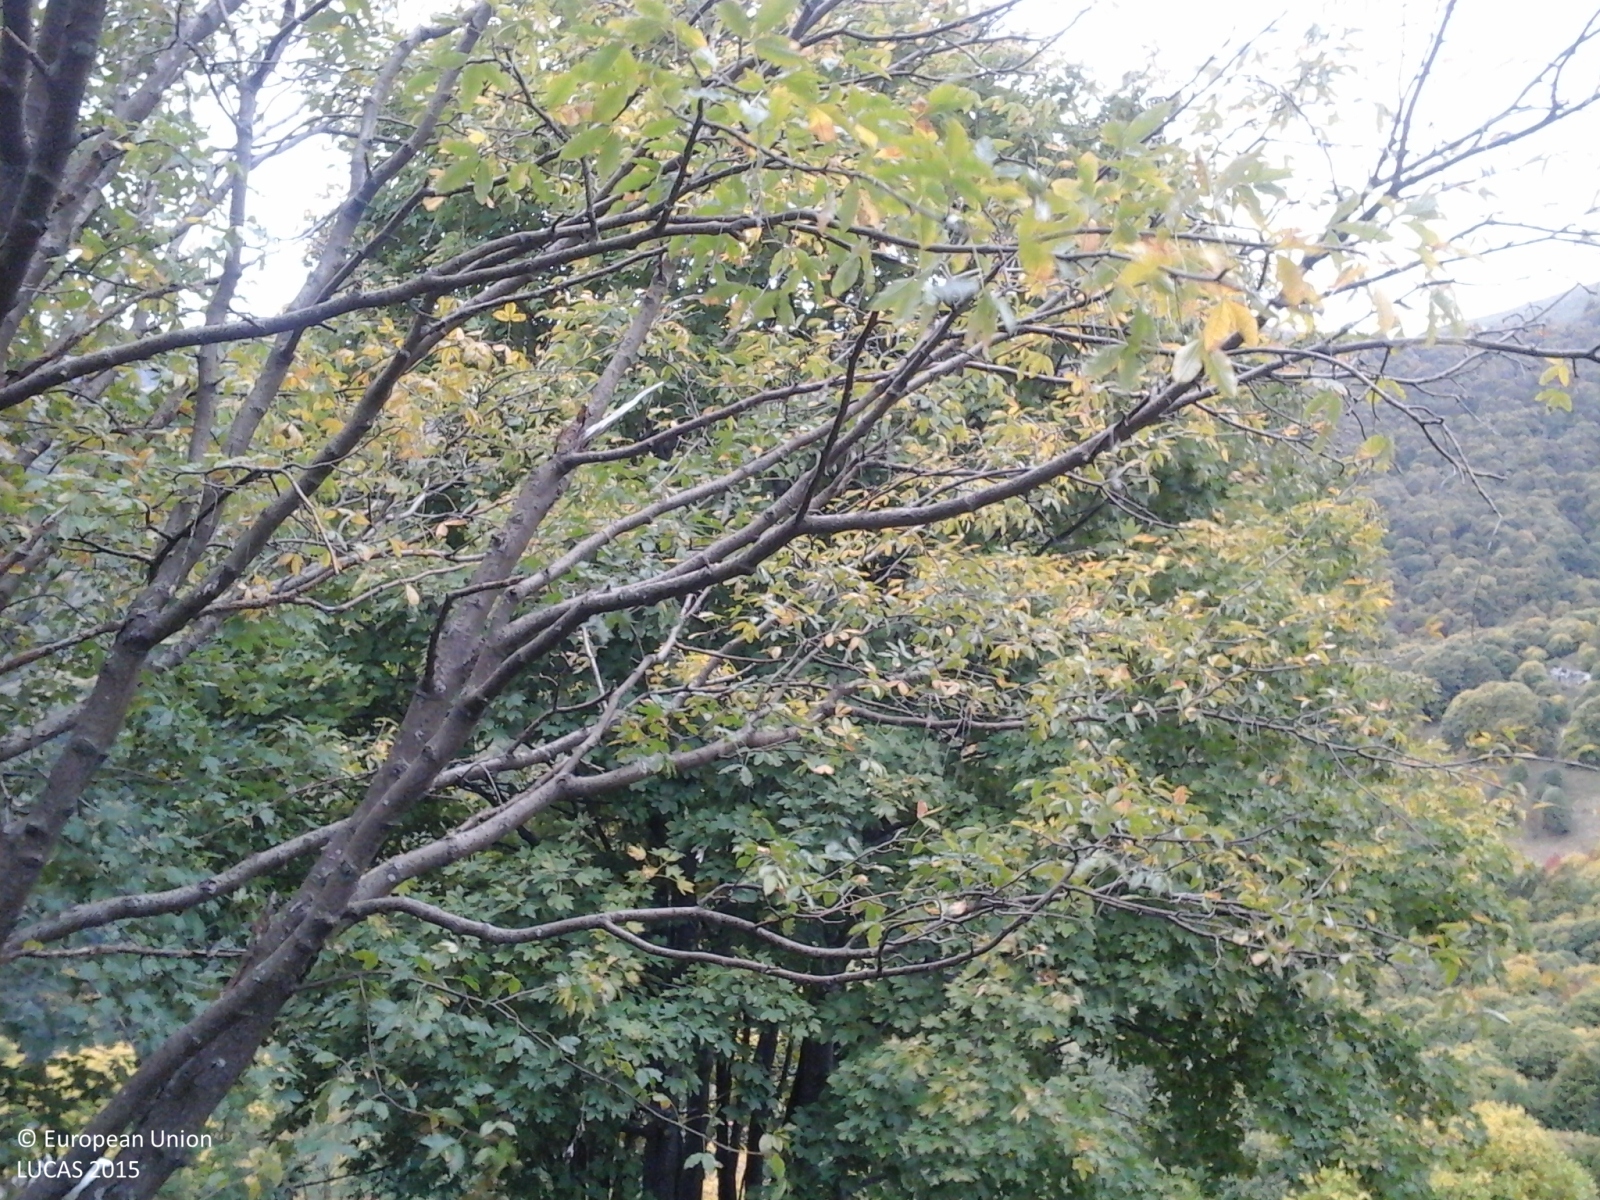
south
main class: Grassland
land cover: Grassland without tree/shrub cover
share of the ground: > 75 %
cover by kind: herbaceous plants 90 %, consolidated bare surface 10 %
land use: Agriculture (excluding fallow land and kitchen gardens)
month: October
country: IT
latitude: 44.0560
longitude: 7.7708
